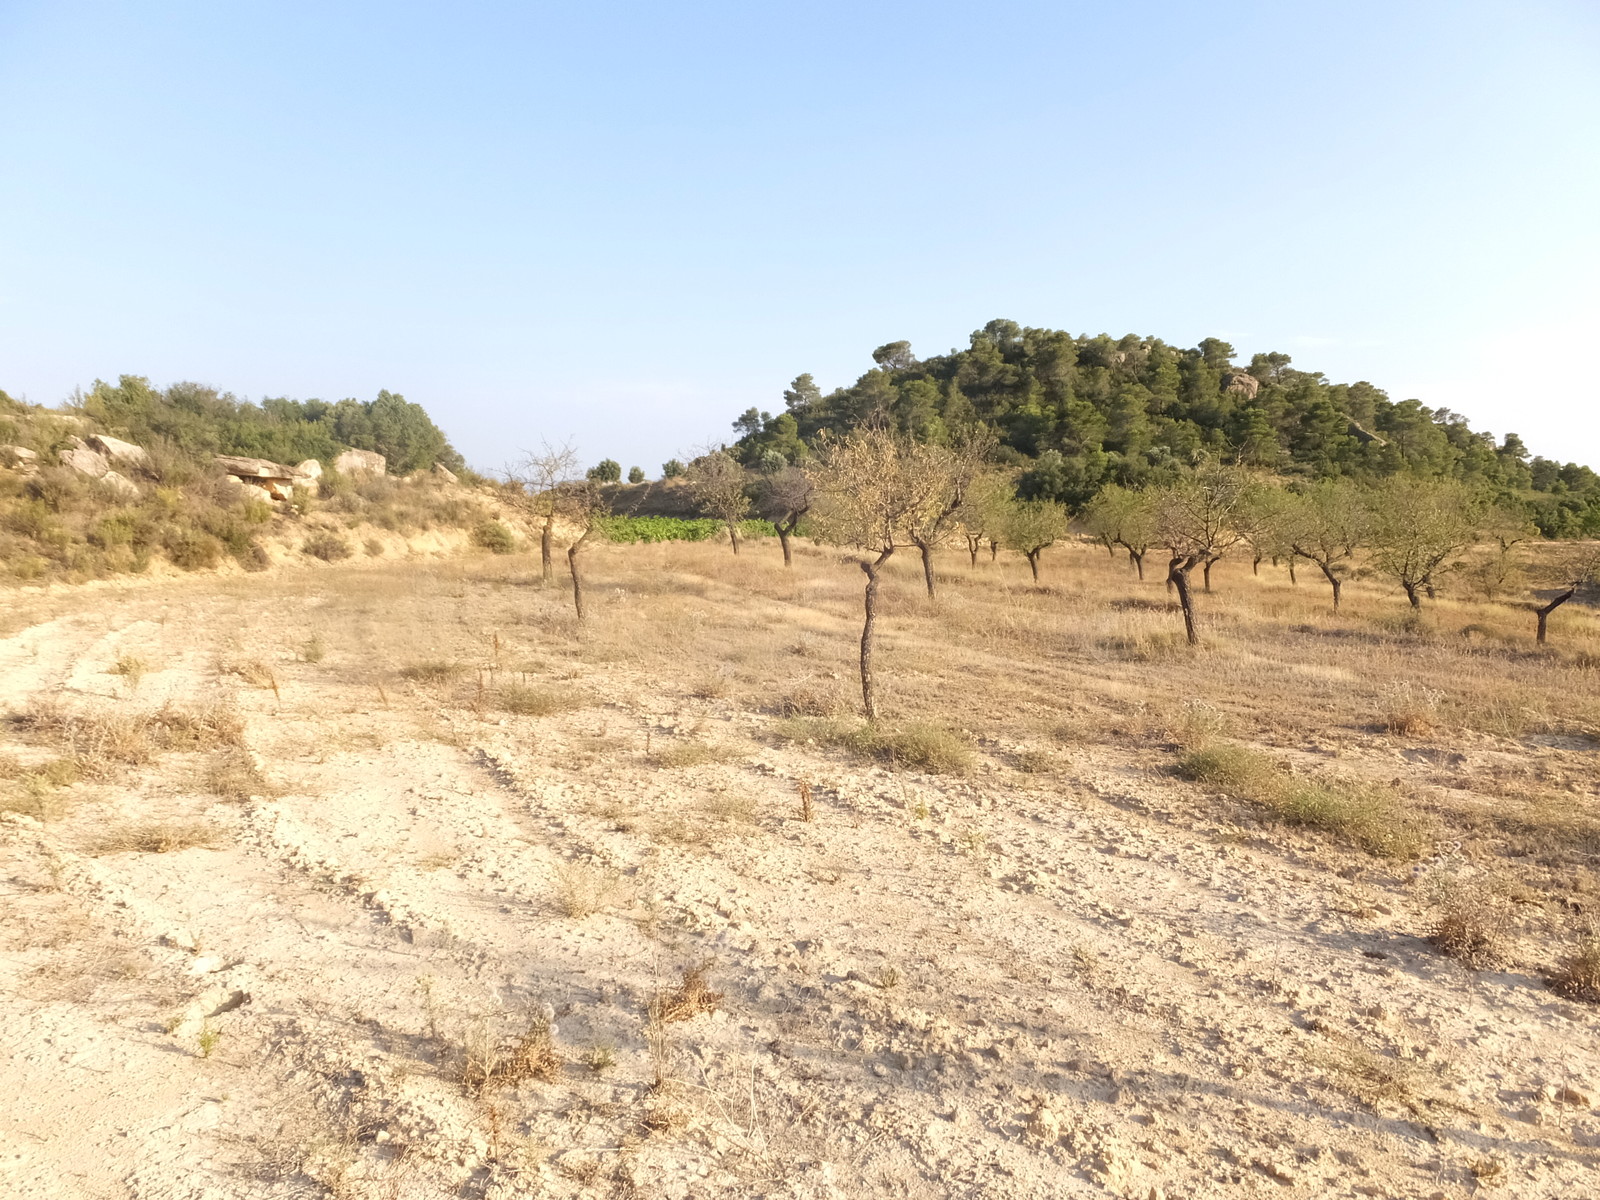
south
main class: Cropland
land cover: Nuts trees
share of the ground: 50 - 75 %
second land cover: Spontaneously vegetated surfaces
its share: < 10 %
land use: Agriculture (excluding fallow land and kitchen gardens)
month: July
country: ES
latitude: 41.0834
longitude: 0.1695
